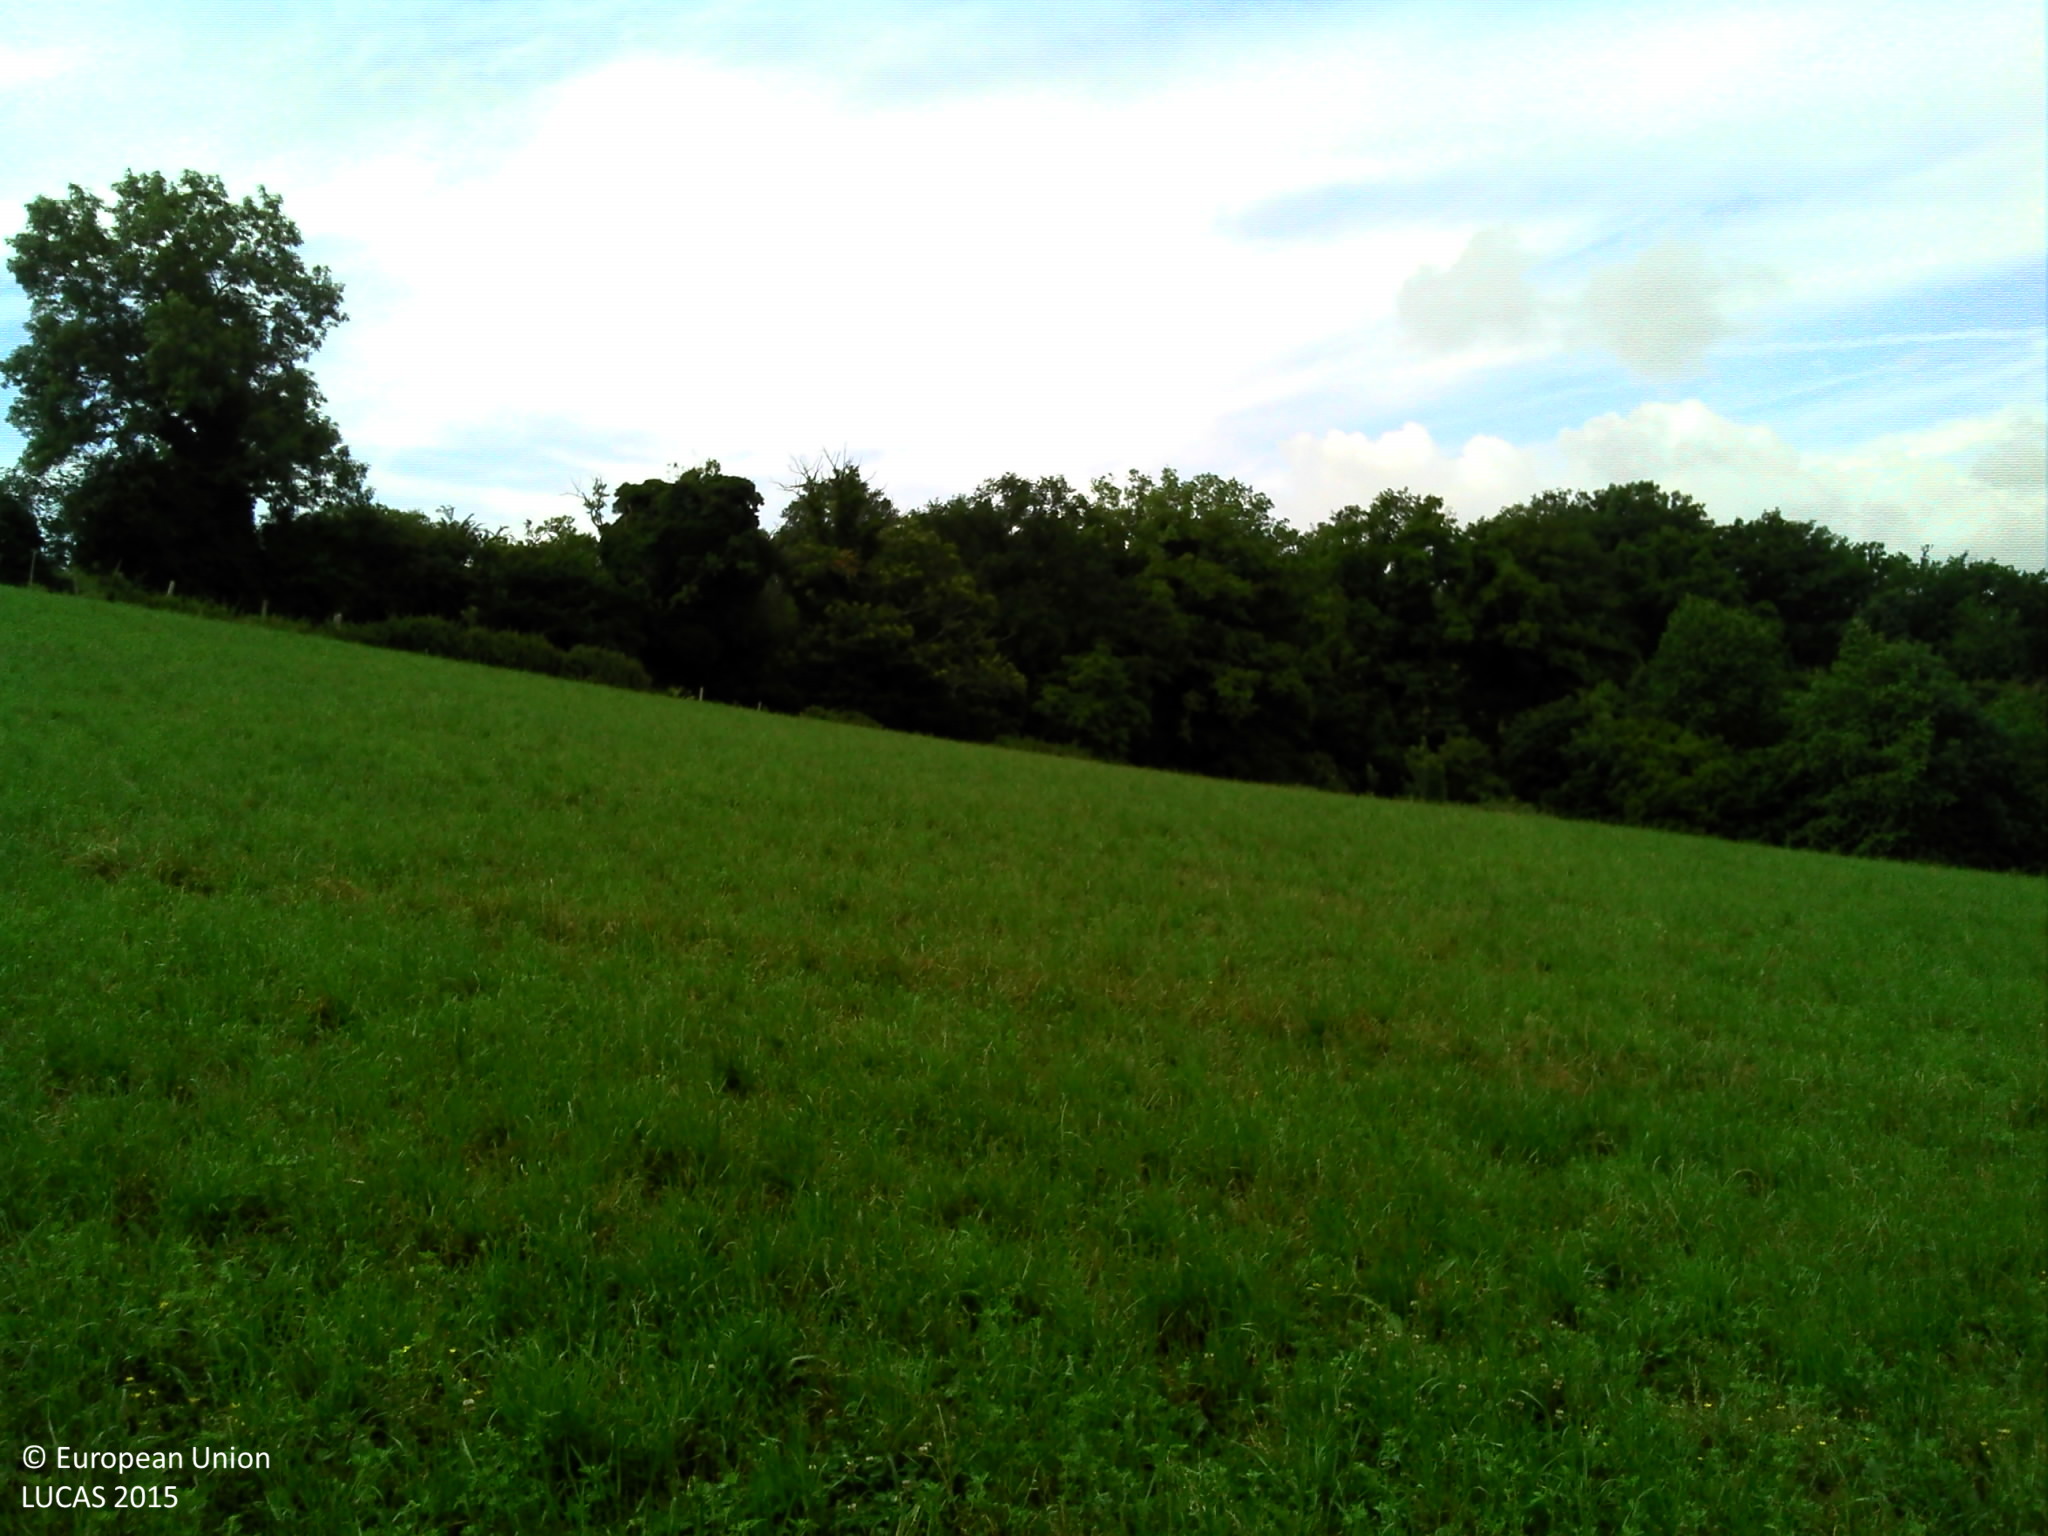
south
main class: Cropland
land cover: Barley
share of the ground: > 75 %
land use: Agriculture (excluding fallow land and kitchen gardens)
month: June
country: FR
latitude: 44.2062
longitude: 2.5077
